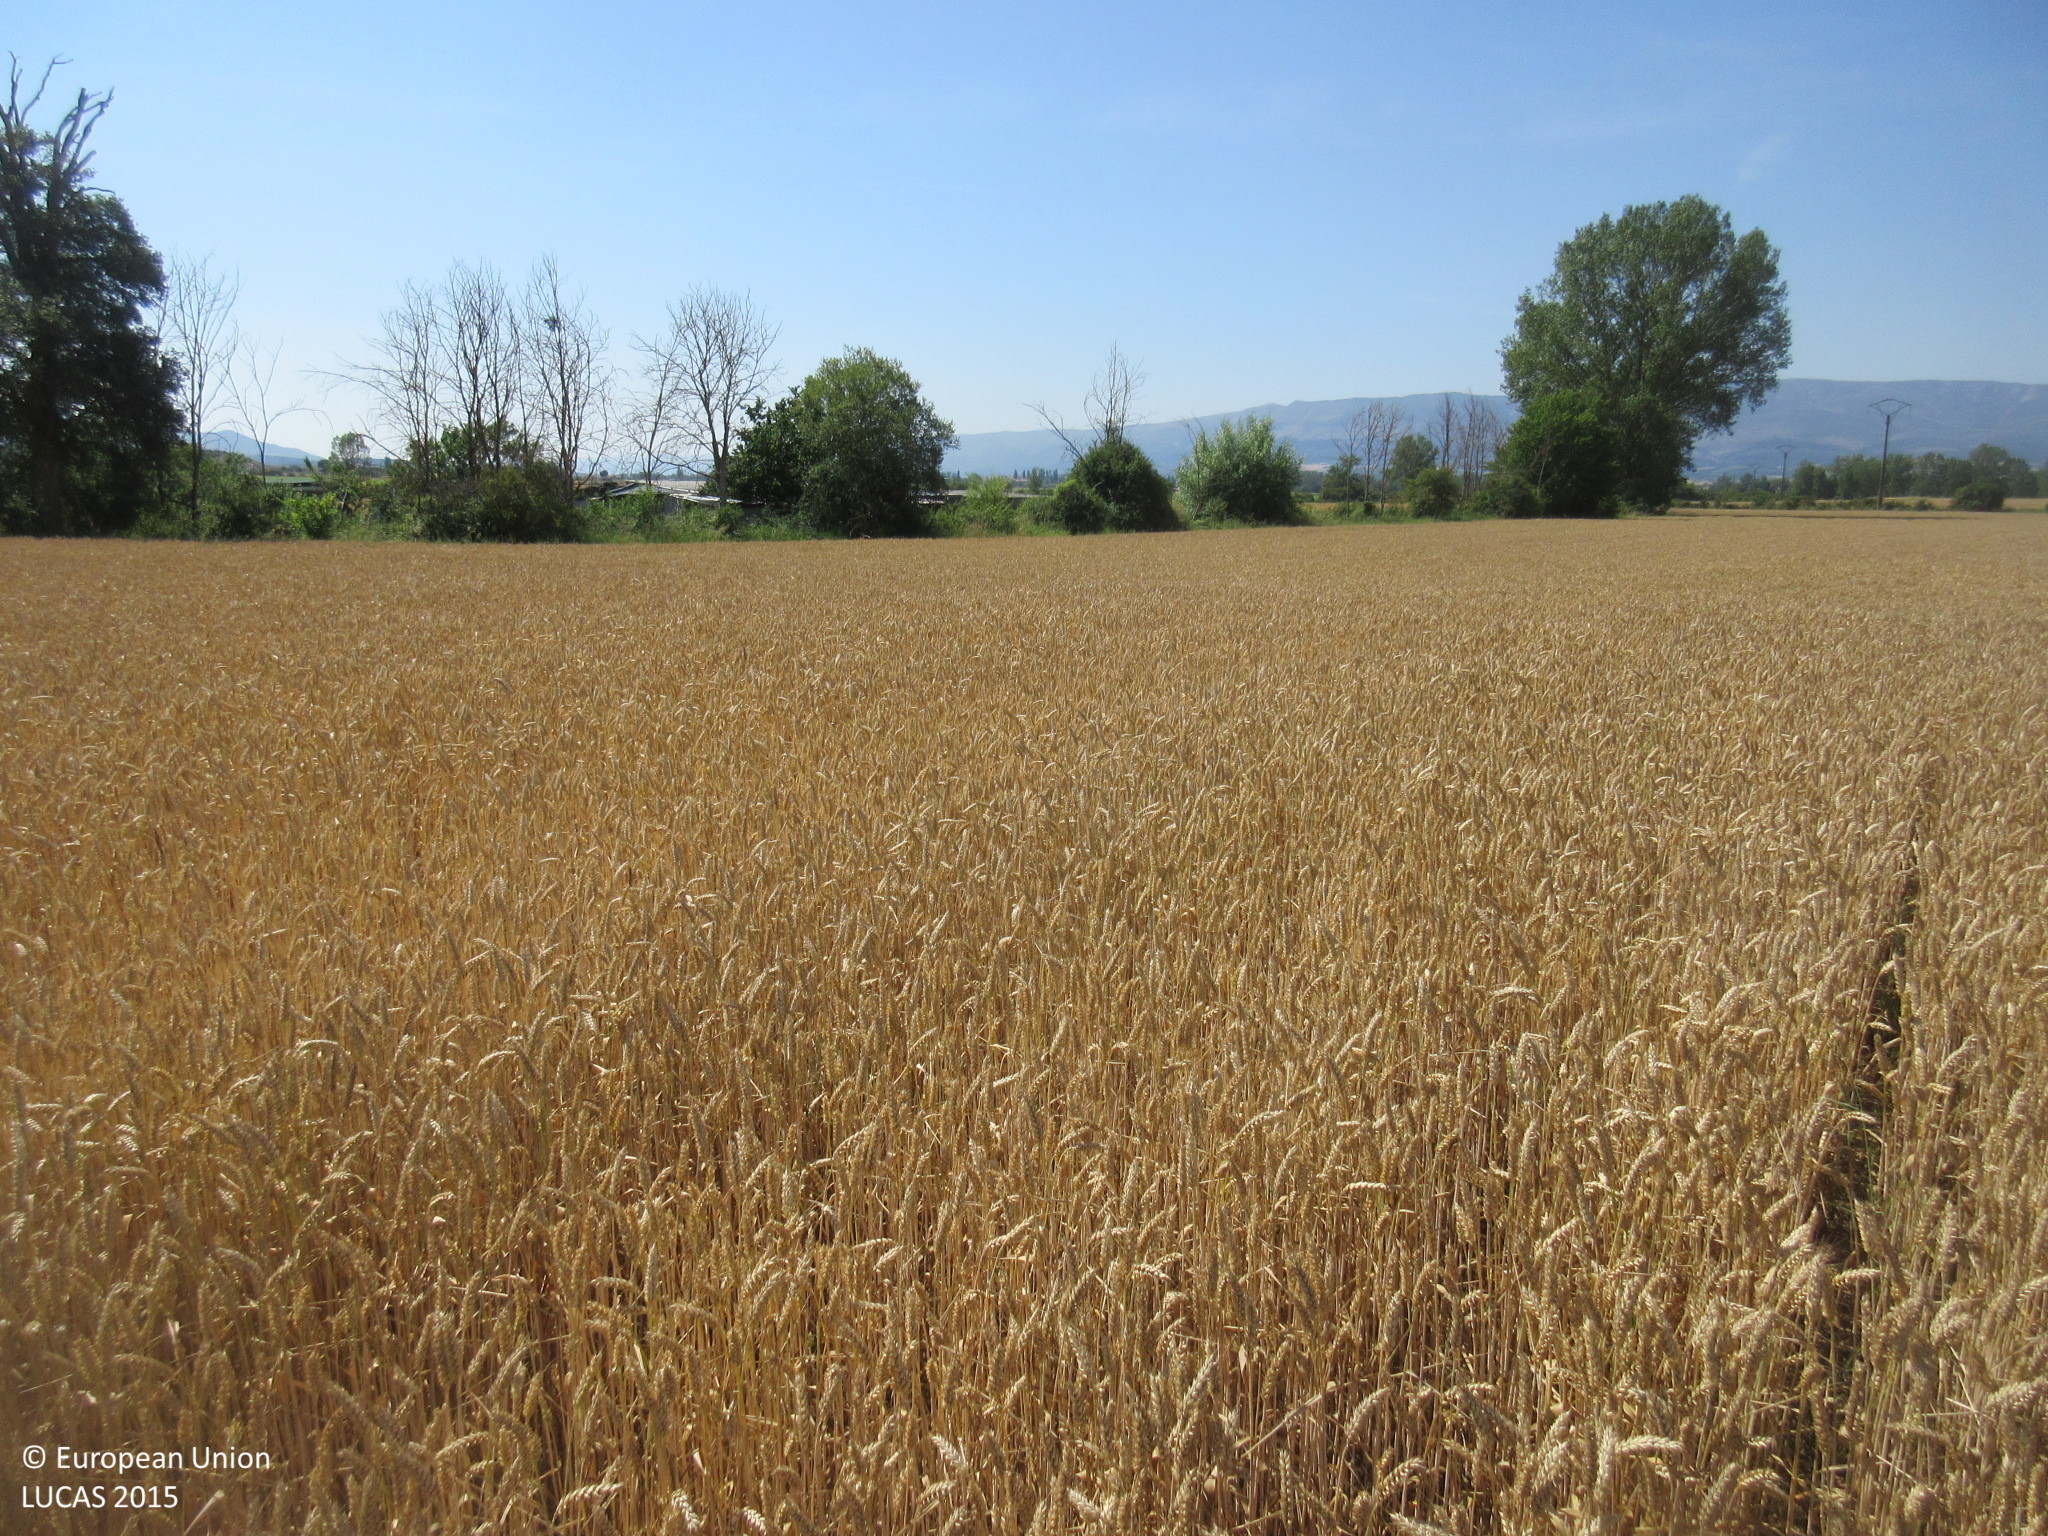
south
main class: Cropland
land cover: Common wheat
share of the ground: > 75 %
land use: Agriculture (excluding fallow land and kitchen gardens)
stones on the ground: < 10 %
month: July
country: ES
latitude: 42.9685
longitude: -3.5141
